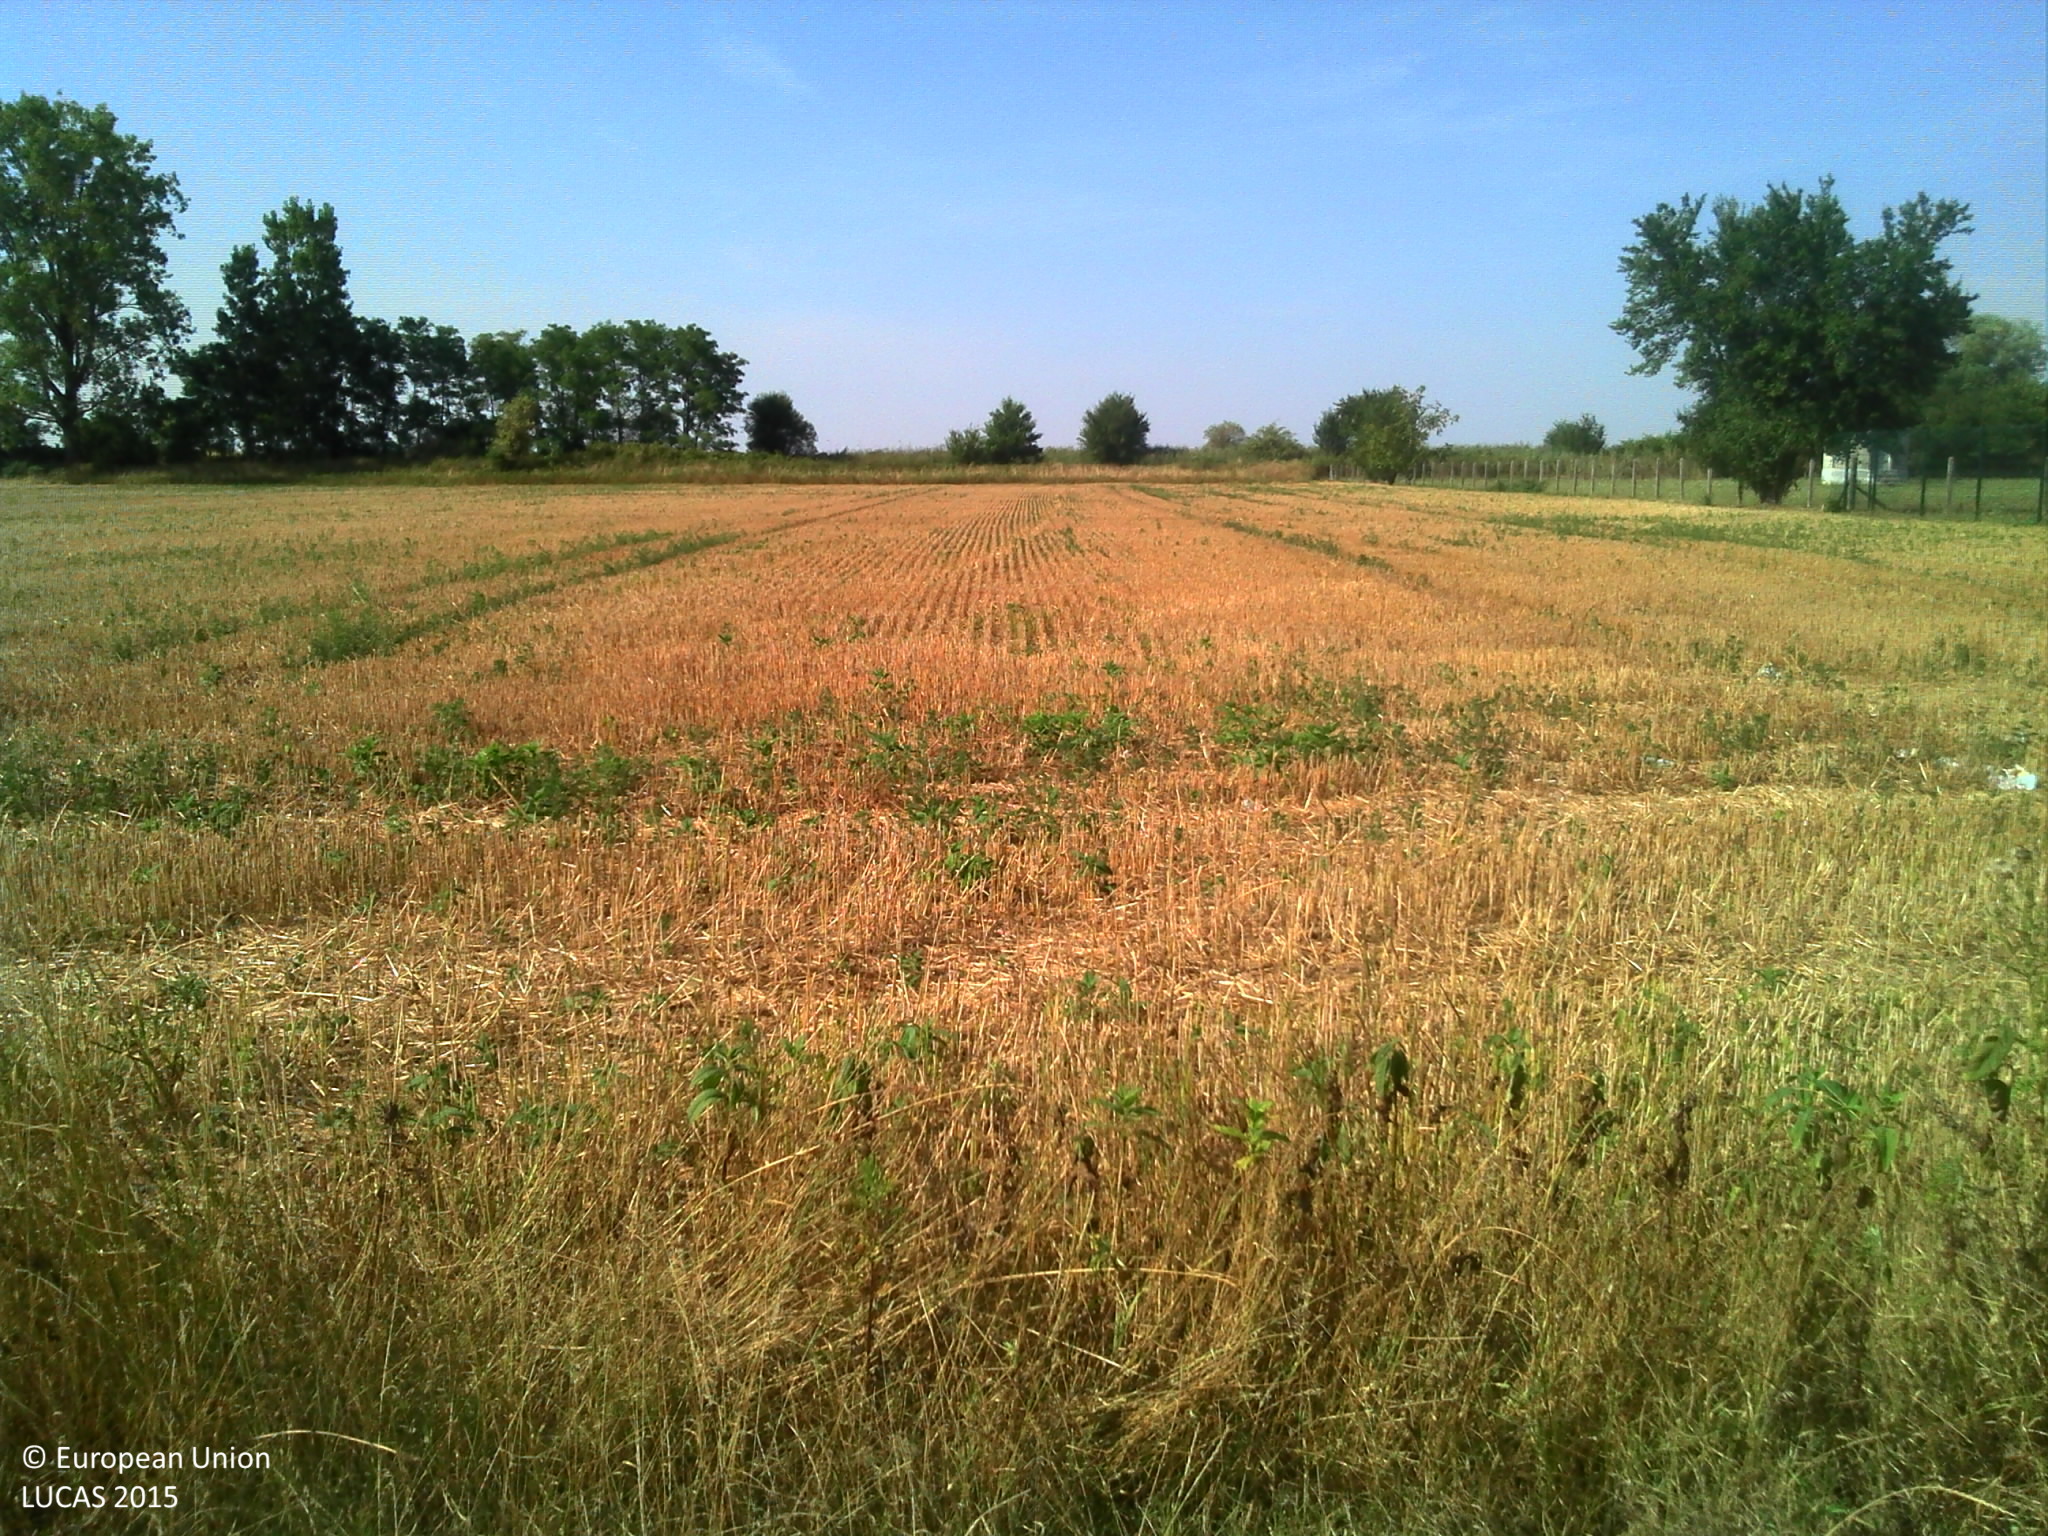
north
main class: Cropland
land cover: Sunflower
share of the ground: > 75 %
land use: Agriculture (excluding fallow land and kitchen gardens)
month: August
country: FR
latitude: 45.6345
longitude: 4.9111
